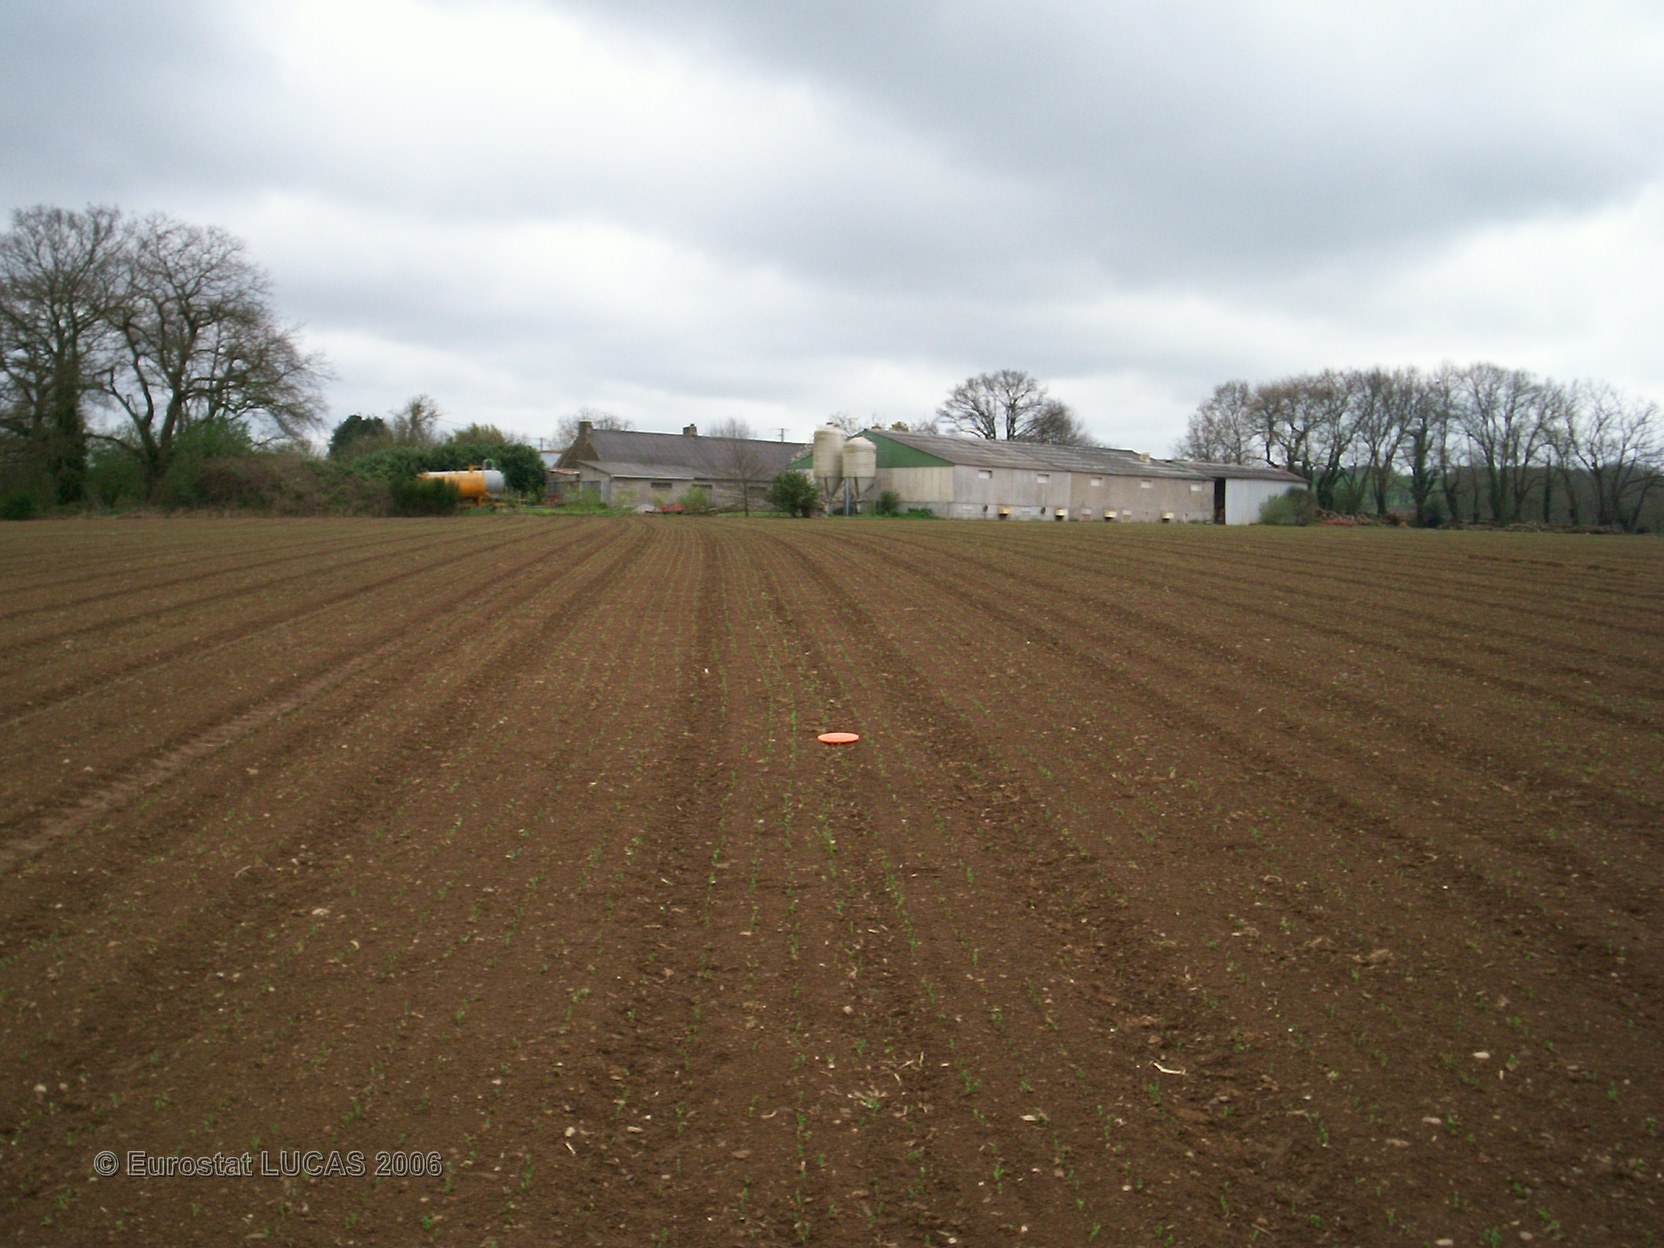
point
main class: Cropland
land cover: Other fresh vegetables
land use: Agriculture (excluding fallow land and kitchen gardens)
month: April
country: FR
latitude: 47.7760
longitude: -2.8622
